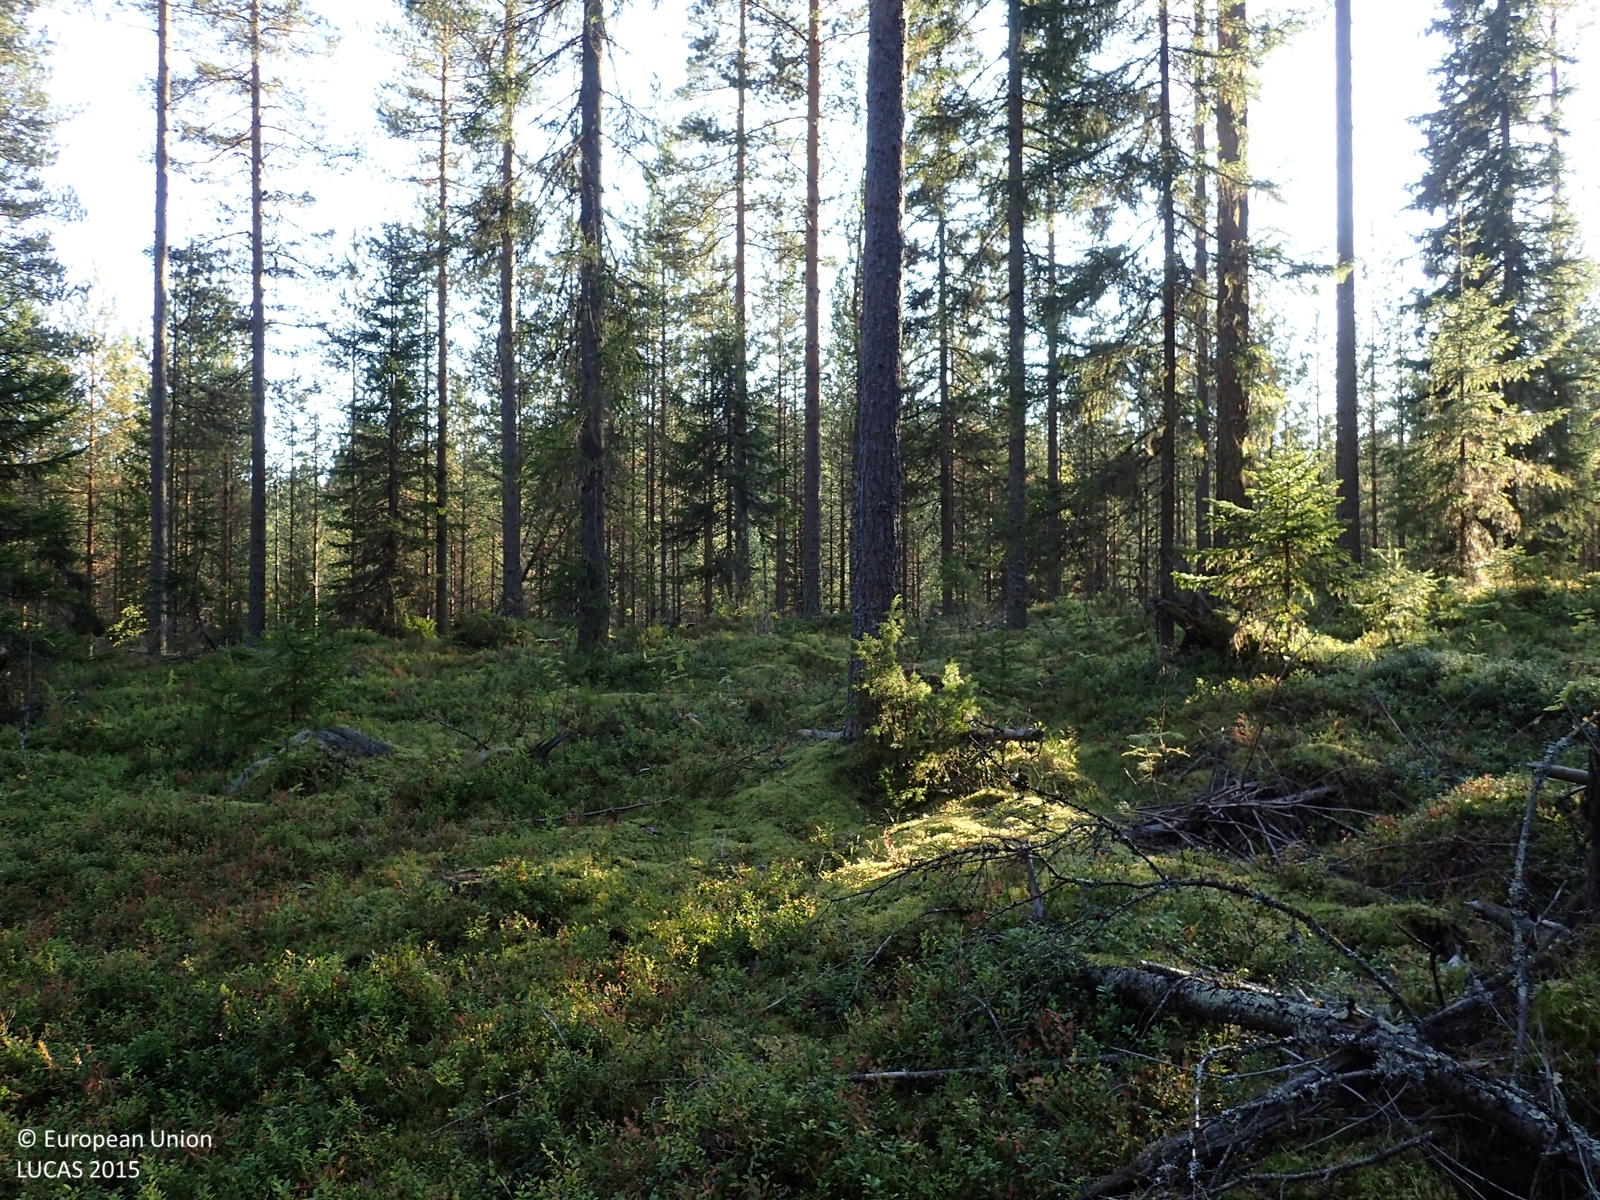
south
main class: Woodland
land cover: Other coniferous woodland
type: boreal forest
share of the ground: > 75 %
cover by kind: coniferous forest trees 75 %, shrubs 20 %, lichens and mosses 5 %
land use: Forestry
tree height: > 5 m
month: September
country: FI
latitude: 62.9091
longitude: 25.6808
